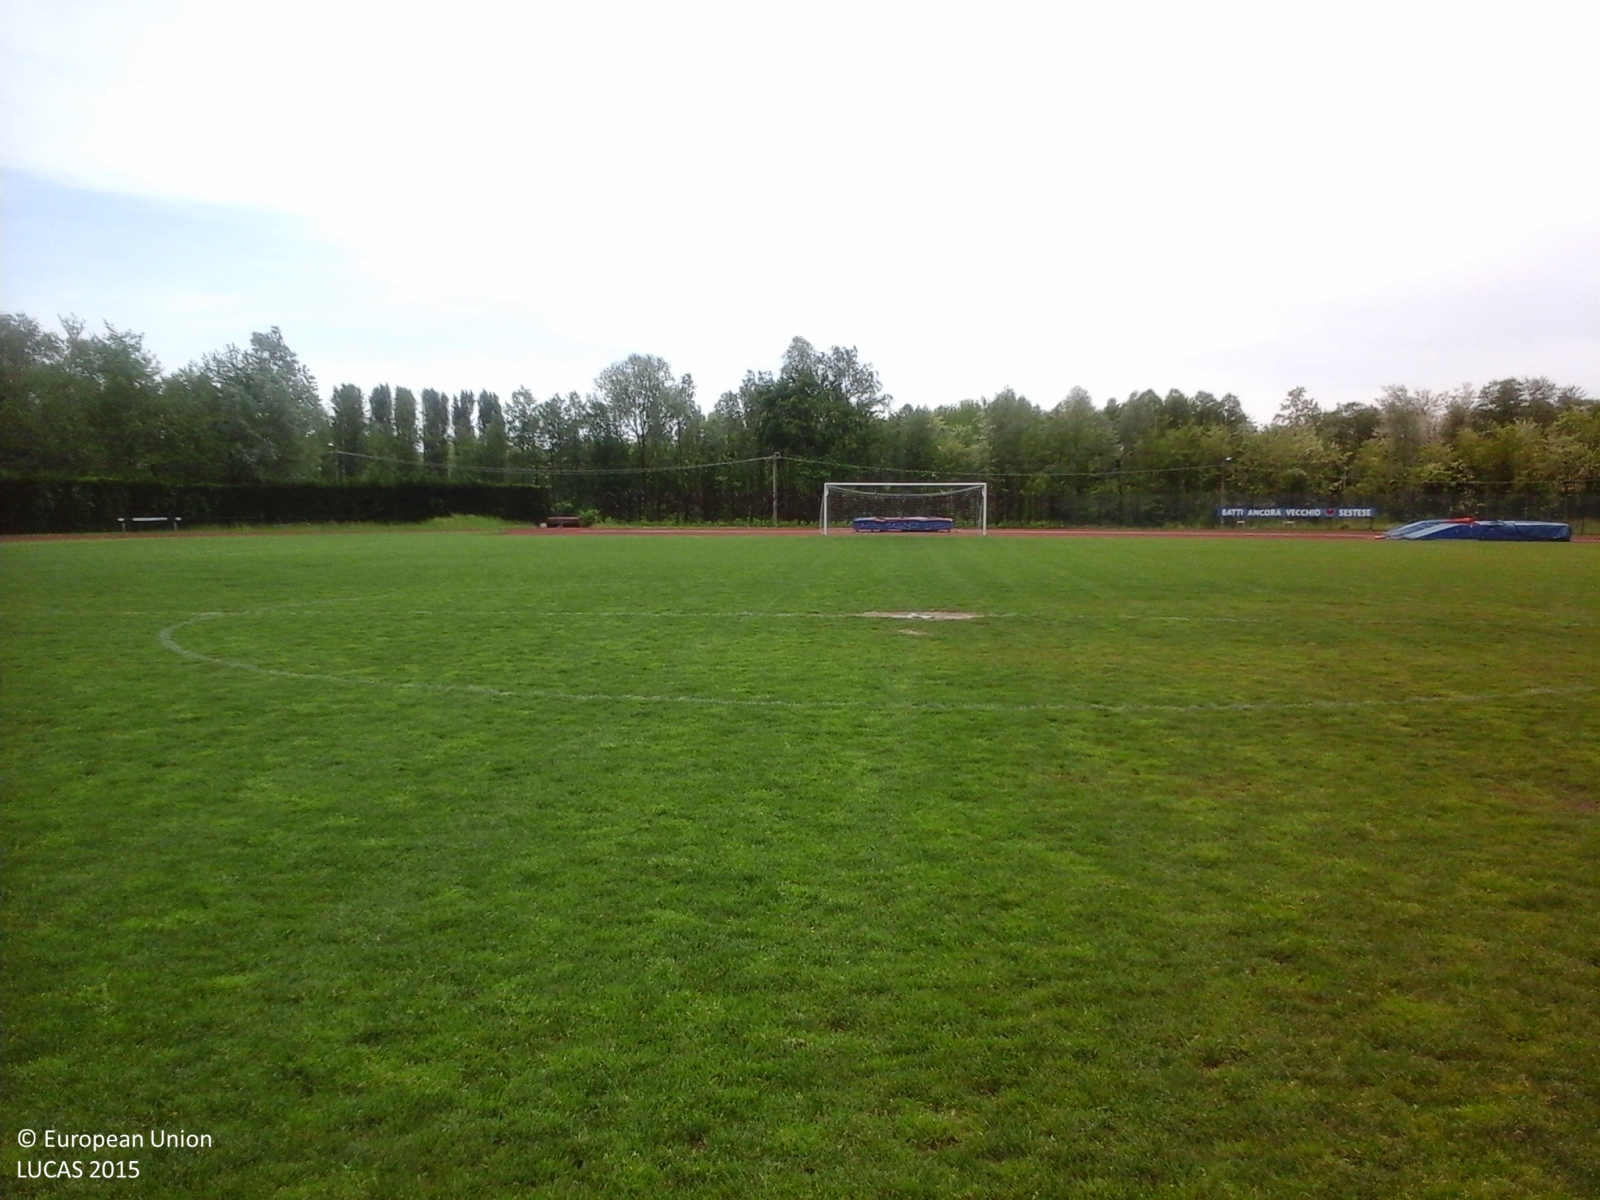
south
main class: Grassland
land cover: Grassland without tree/shrub cover
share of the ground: > 75 %
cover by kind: herbaceous plants 100 %
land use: Sport
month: May
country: IT
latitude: 45.7298
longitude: 8.6272
